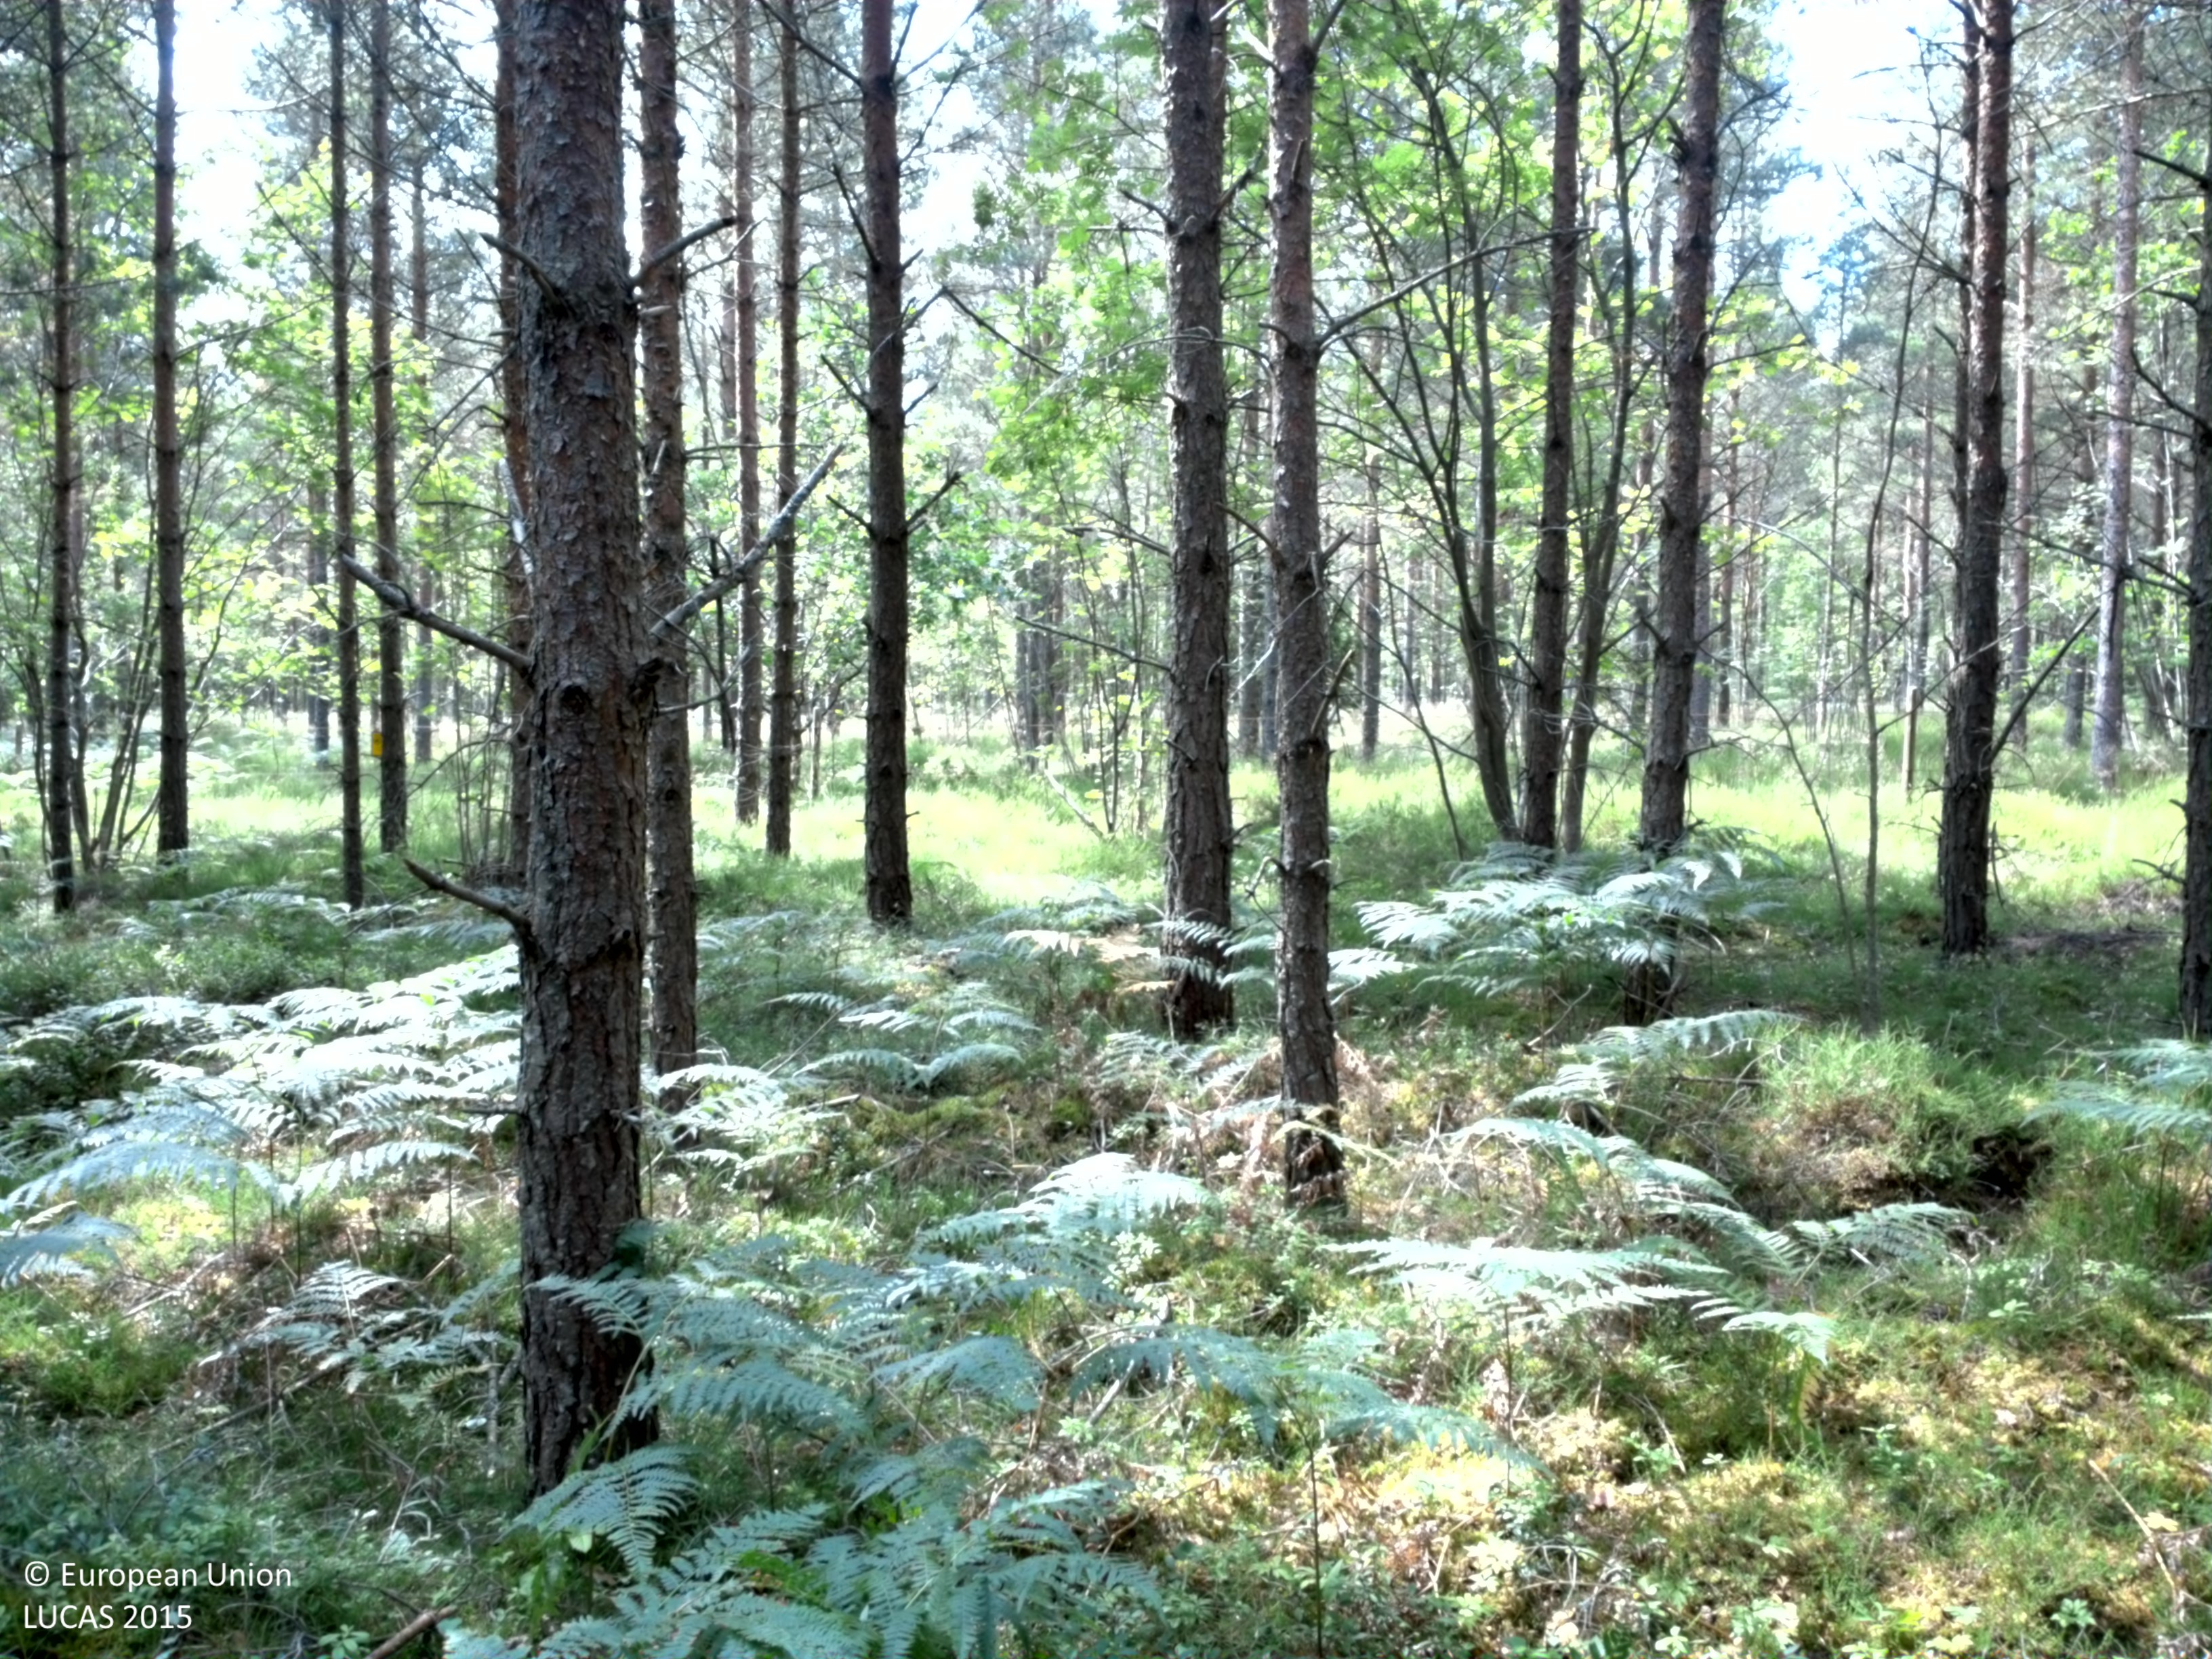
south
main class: Woodland
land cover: Pine dominated coniferous woodland
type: hemiboreal forest and nemoral coniferous forest and mixed broadleaved-coniferous forest
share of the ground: > 75 %
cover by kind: coniferous forest trees 80 %, herbaceous plants 15 %, broadleaved forest trees 5 %
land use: Forestry
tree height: > 5 m
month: July
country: SE
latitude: 57.3554
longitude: 18.7371
